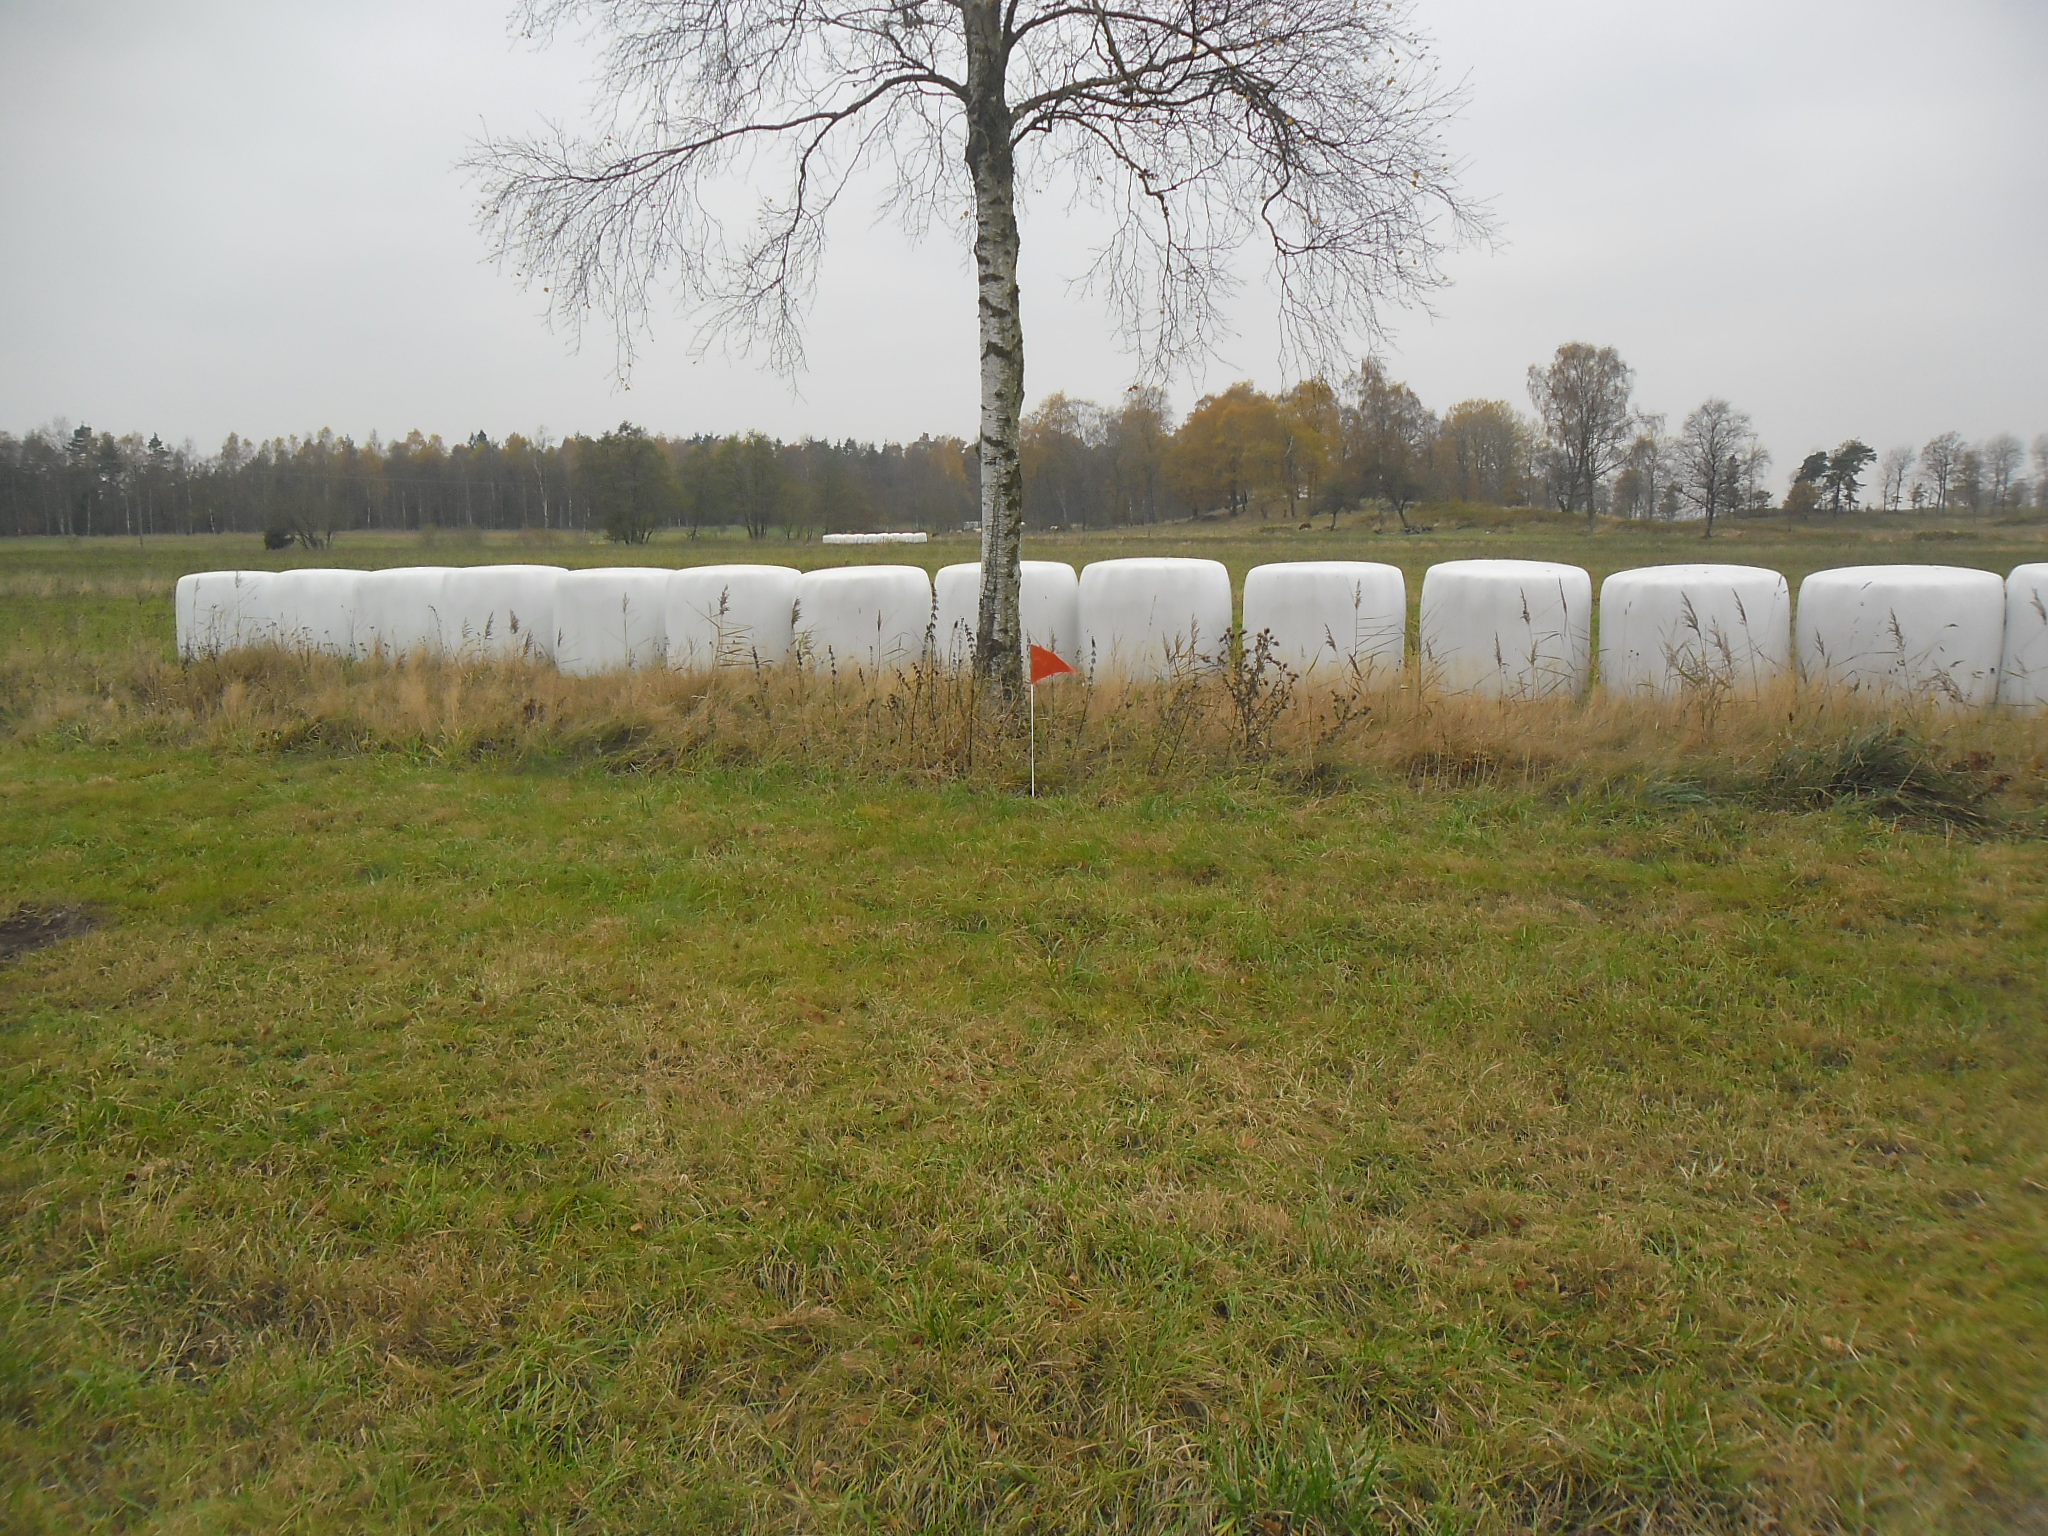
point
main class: Grassland
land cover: Grassland without tree/shrub cover
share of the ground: > 75 %
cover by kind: herbaceous plants 100 %
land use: Agriculture (excluding fallow land and kitchen gardens)
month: October
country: SE
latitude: 56.4719
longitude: 13.1950
